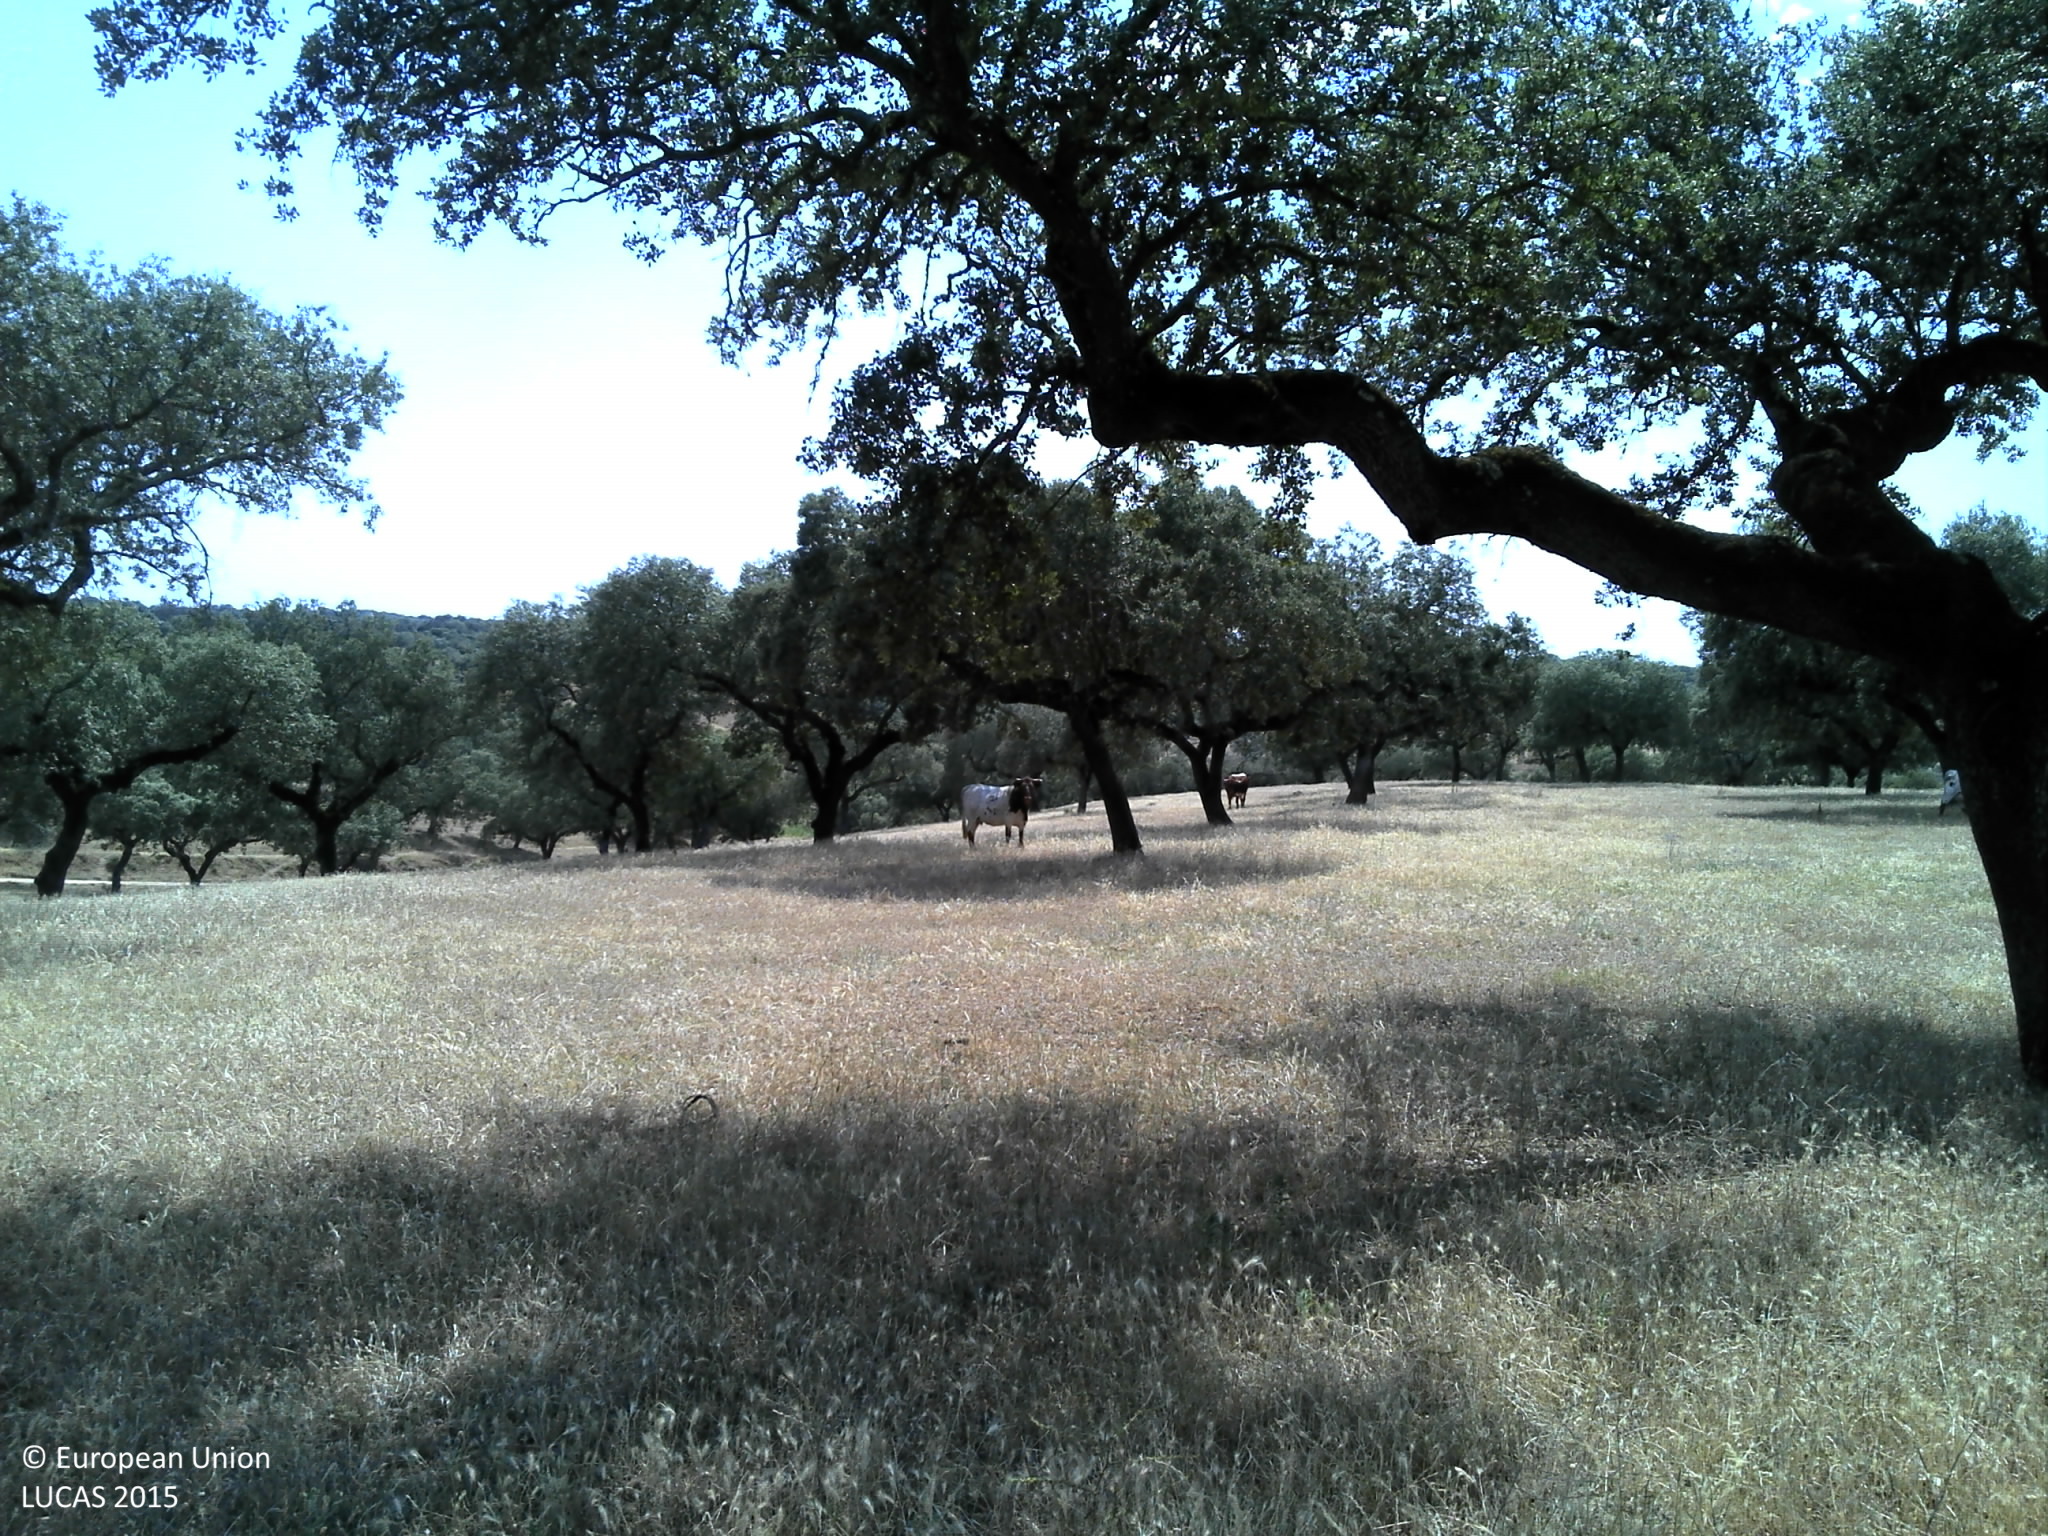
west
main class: Woodland
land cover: Broadleaved woodland
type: broadleaved evergreen forest
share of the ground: 25 - 50 %
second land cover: Grassland without tree/shrub cover
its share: 25 - 50 %
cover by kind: unconsolidated bare surface 40 %, broadleaved forest trees 30 %, herbaceous plants 30 %
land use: Forestry
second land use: Agriculture (excluding fallow land and kitchen gardens)
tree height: > 5 m
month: May
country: PT
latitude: 38.8561
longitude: -7.8470
